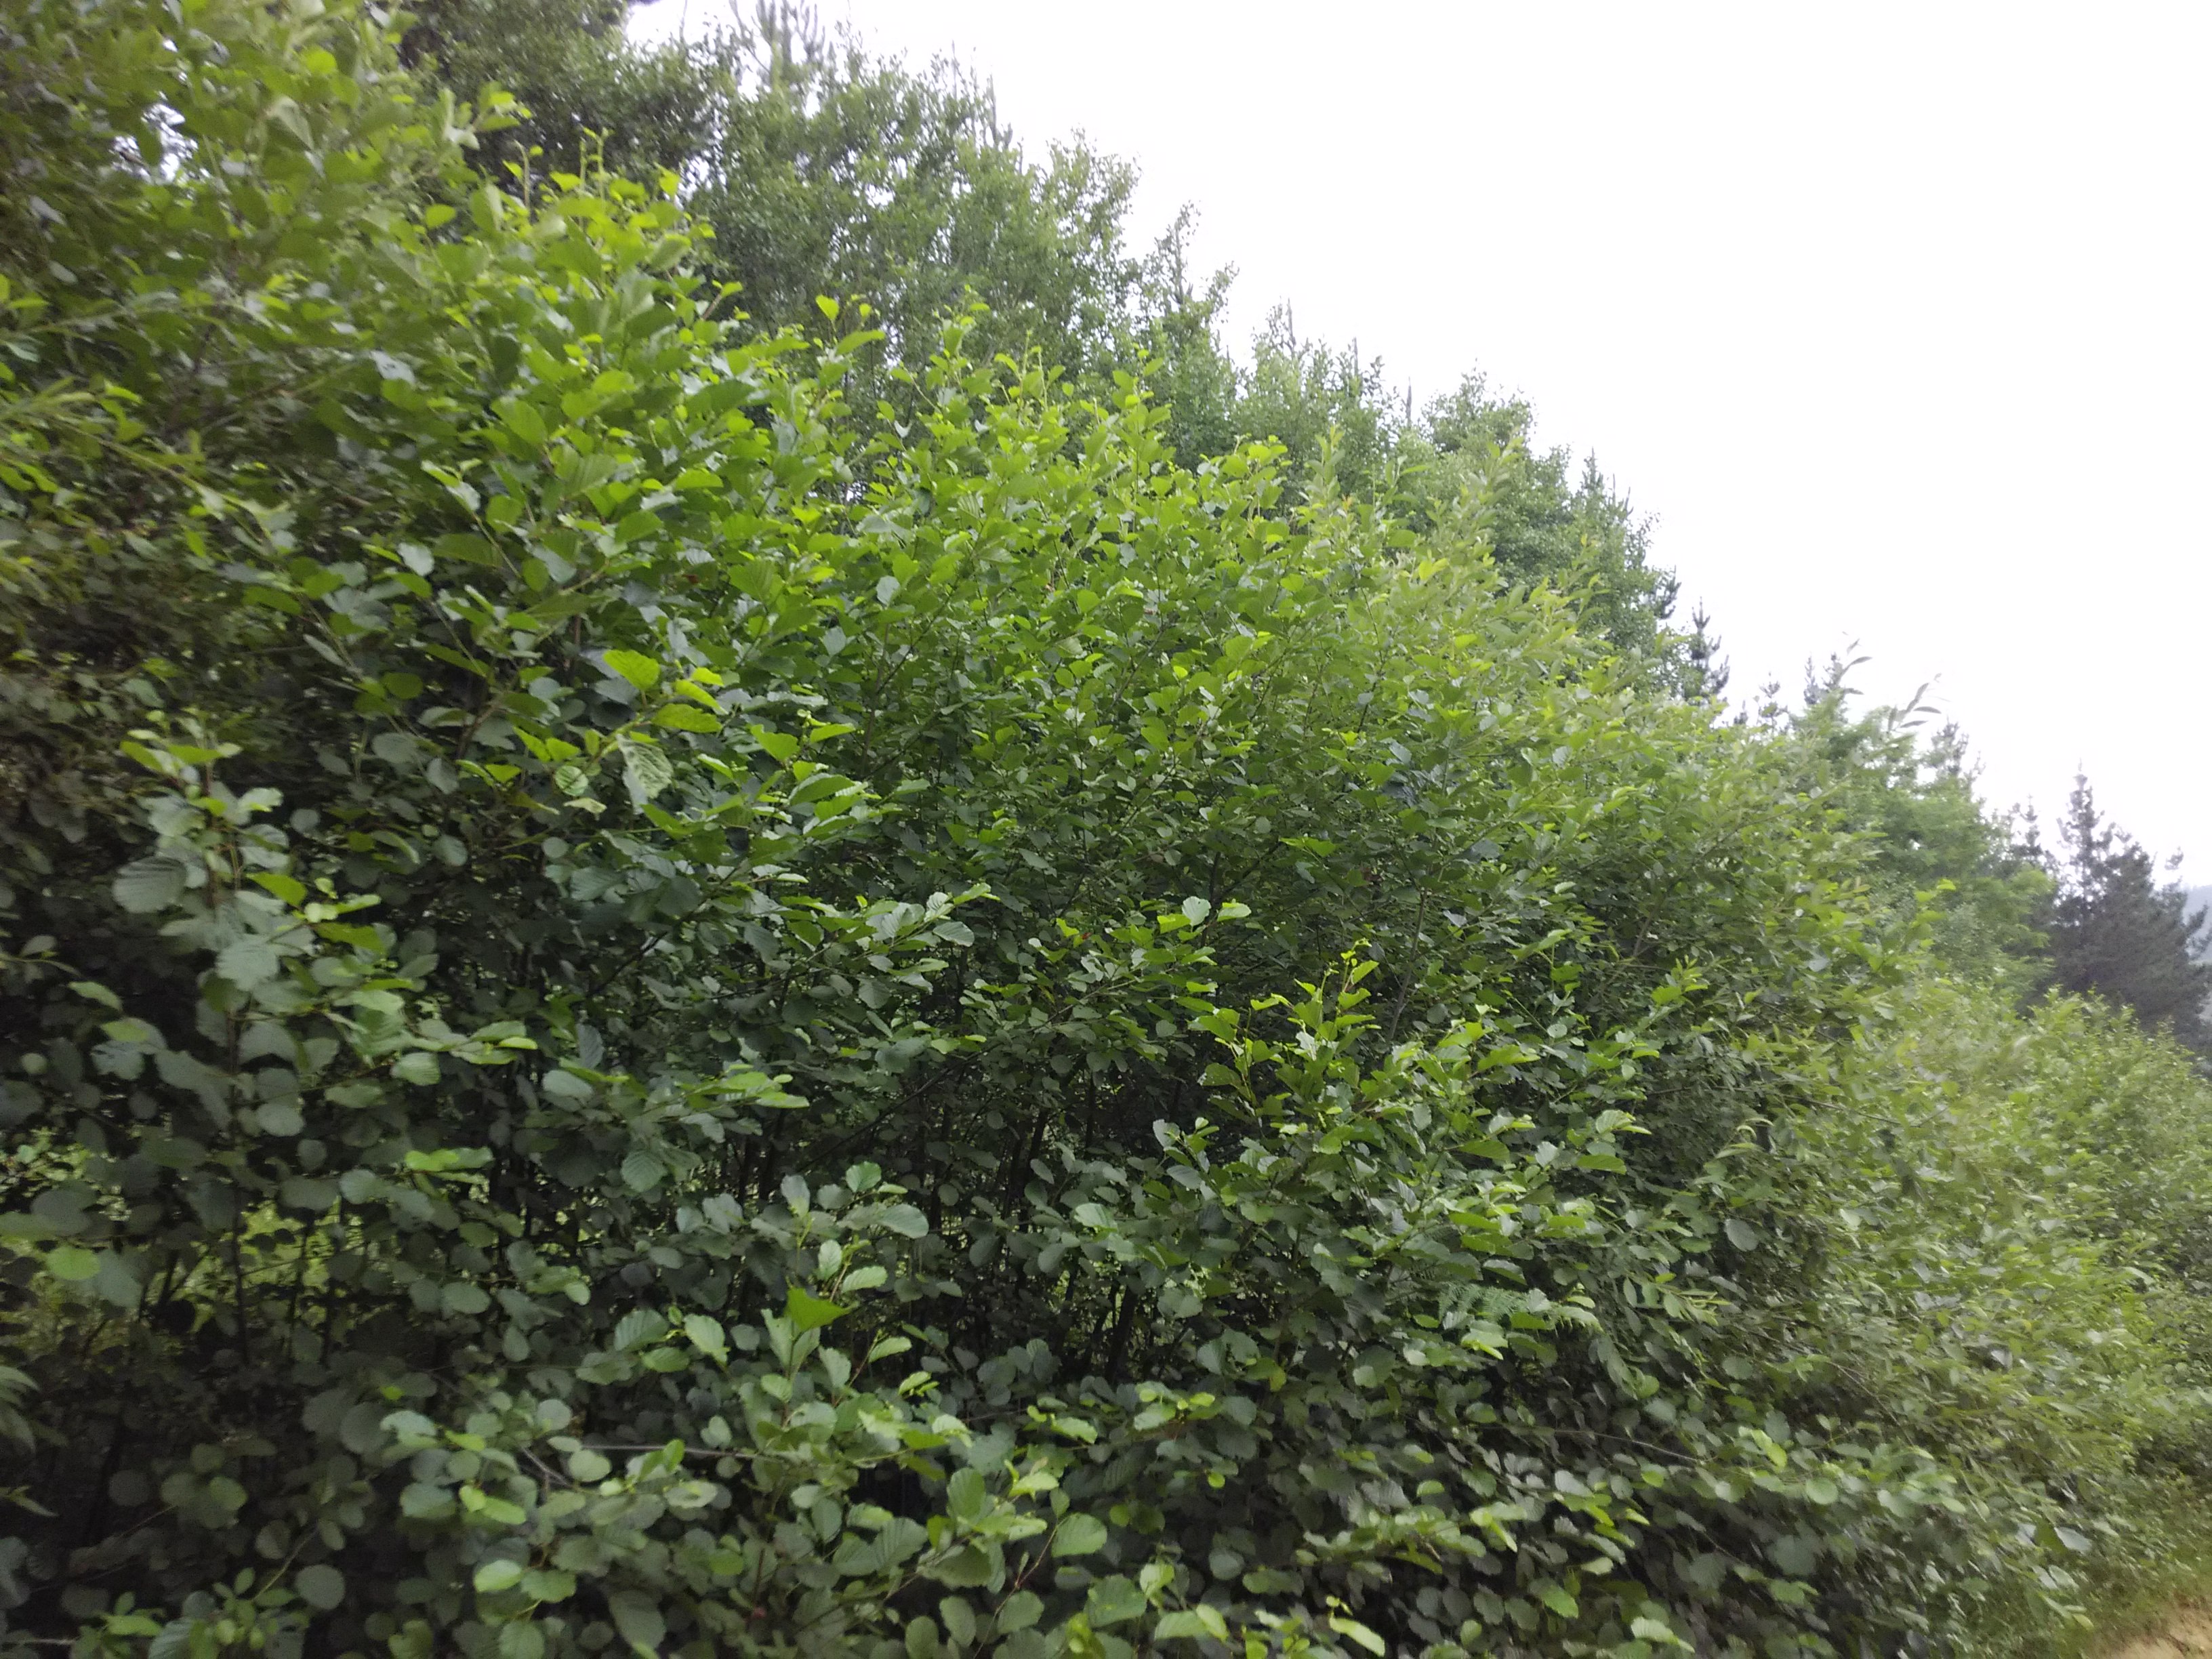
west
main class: Woodland
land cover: Pine dominated coniferous woodland
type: exotic forest
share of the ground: > 75 %
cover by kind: coniferous forest trees 90 %, shrubs 10 %
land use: Forestry
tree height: > 5 m
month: July
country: ES
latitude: 43.0400
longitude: -2.2365
